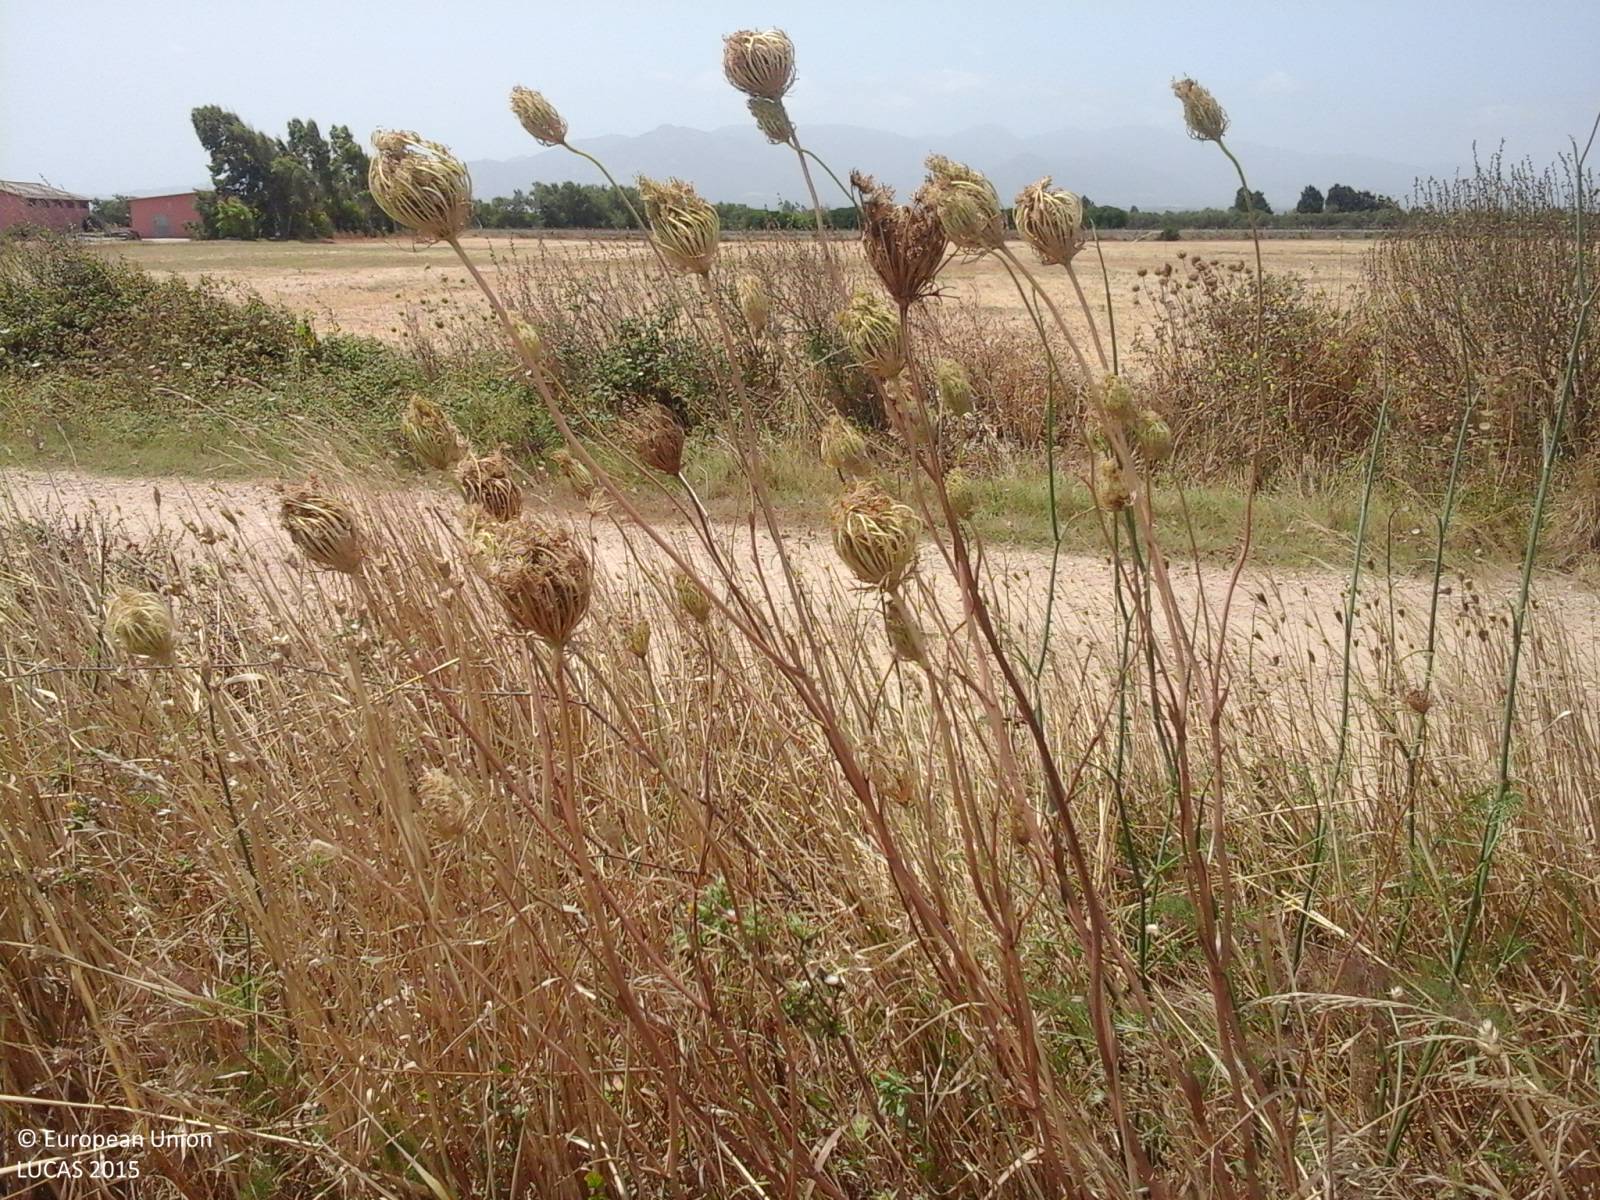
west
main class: Cropland
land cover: Common wheat
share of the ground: > 75 %
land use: Agriculture (excluding fallow land and kitchen gardens)
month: July
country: IT
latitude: 39.5716
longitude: 8.7848
